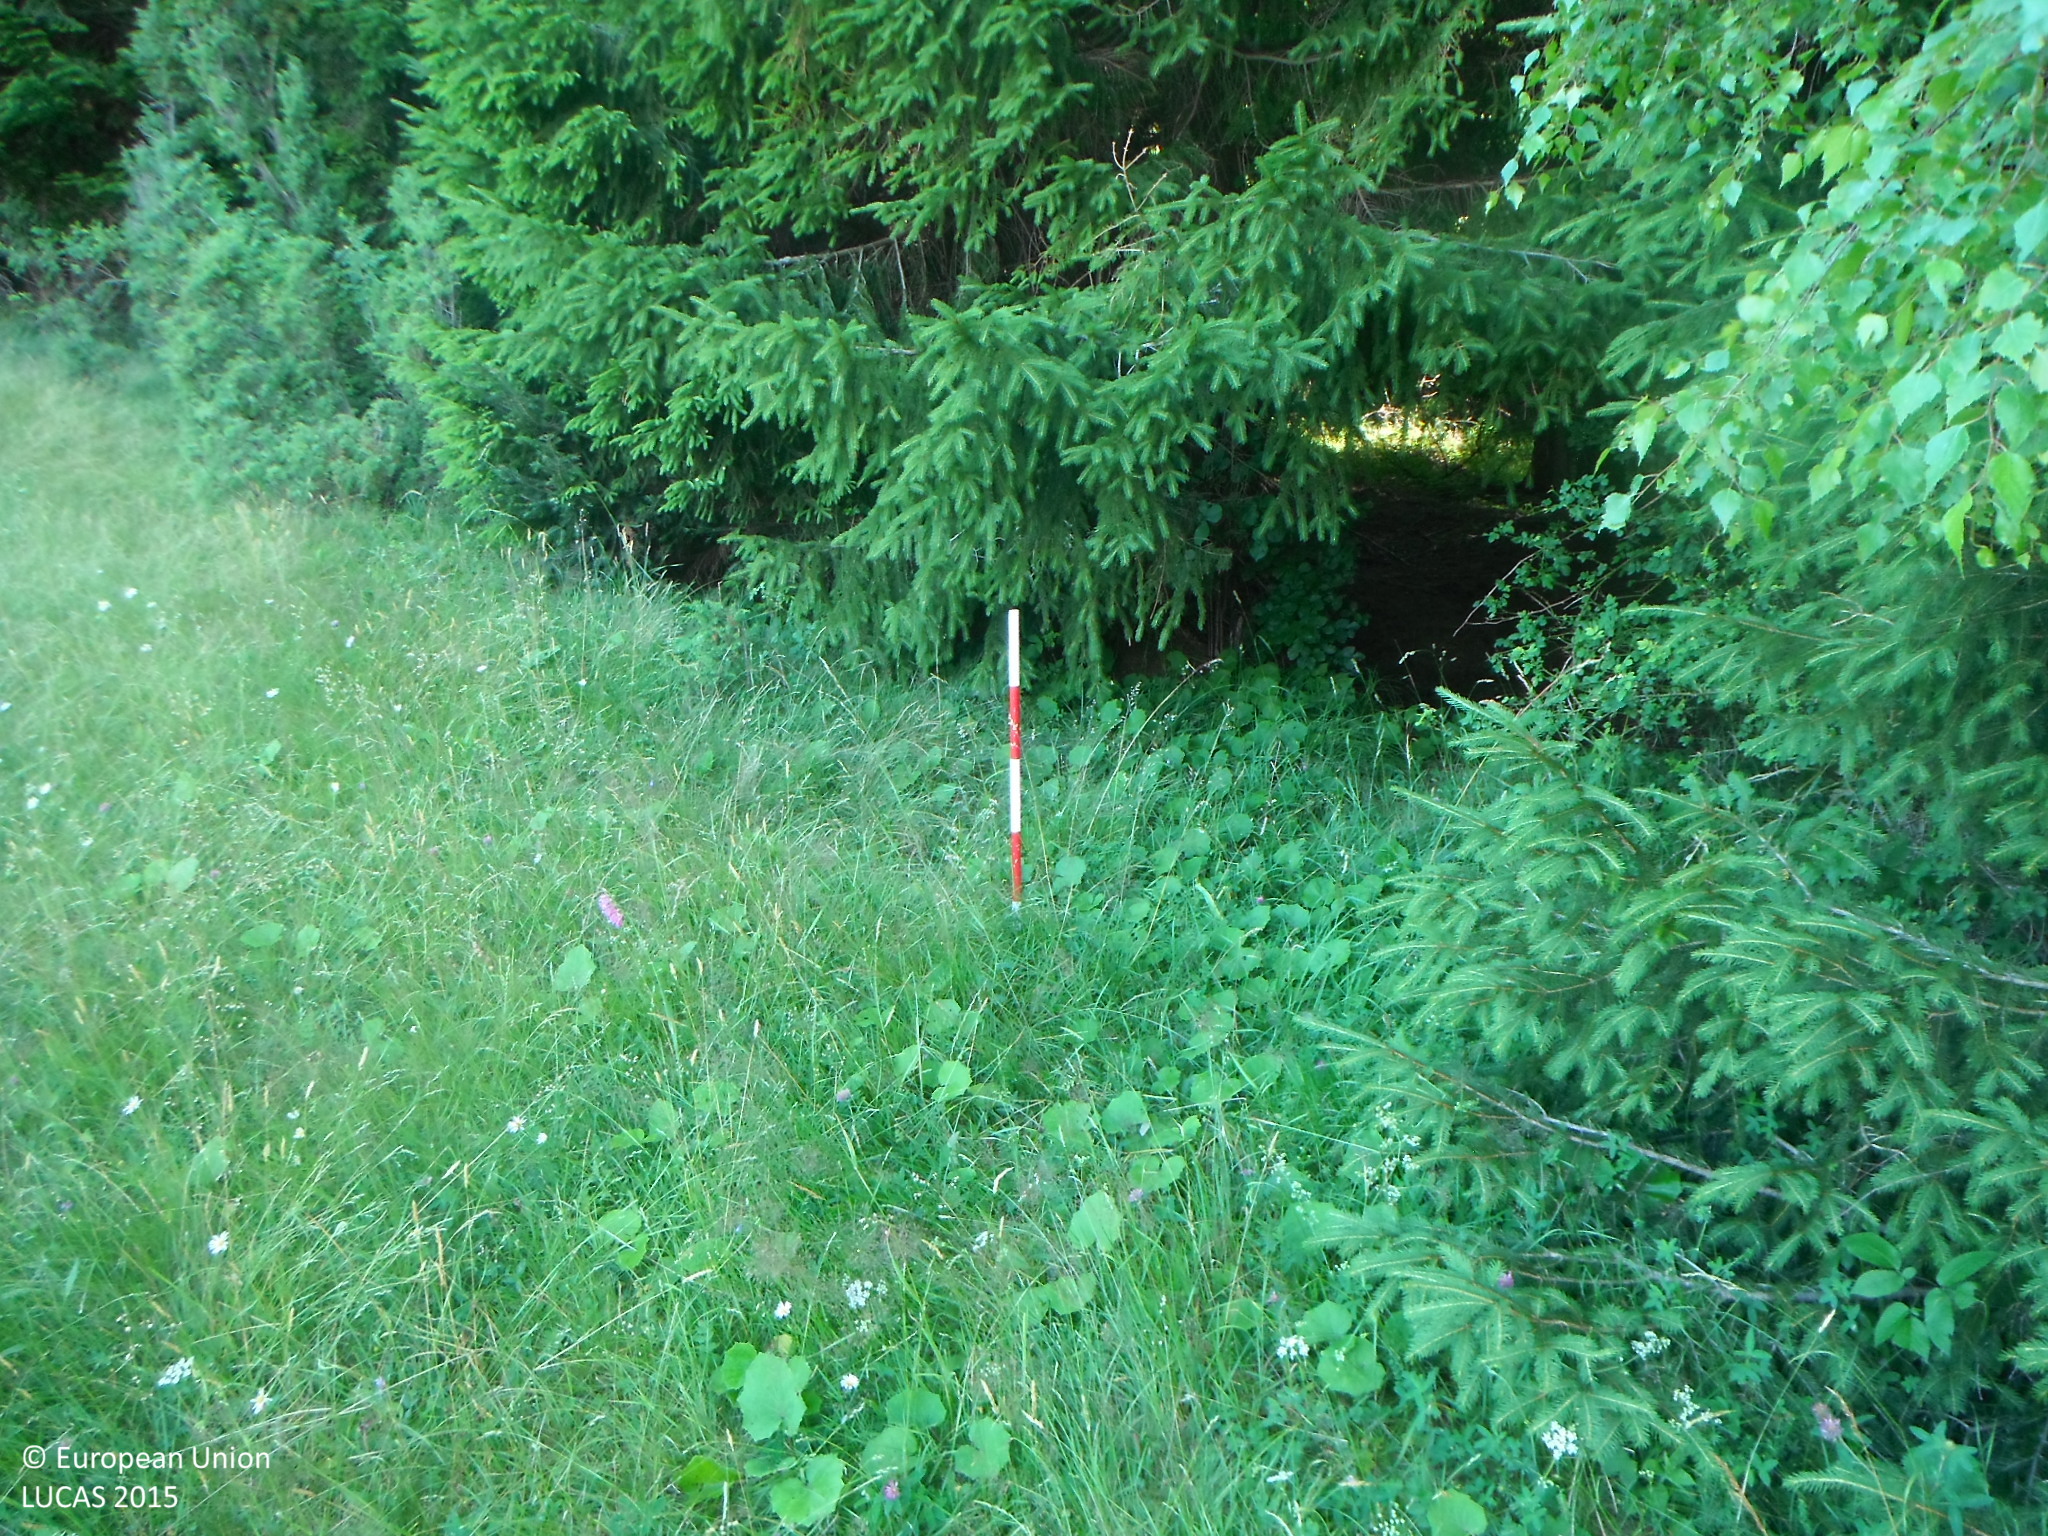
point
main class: Woodland
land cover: Spruce dominated coniferous woodland
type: alpine coniferous forest
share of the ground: > 75 %
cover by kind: coniferous forest trees 95 %, broadleaved forest trees 5 %
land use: Forestry
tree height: > 5 m
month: July
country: SK
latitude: 49.3050
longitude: 19.1971
